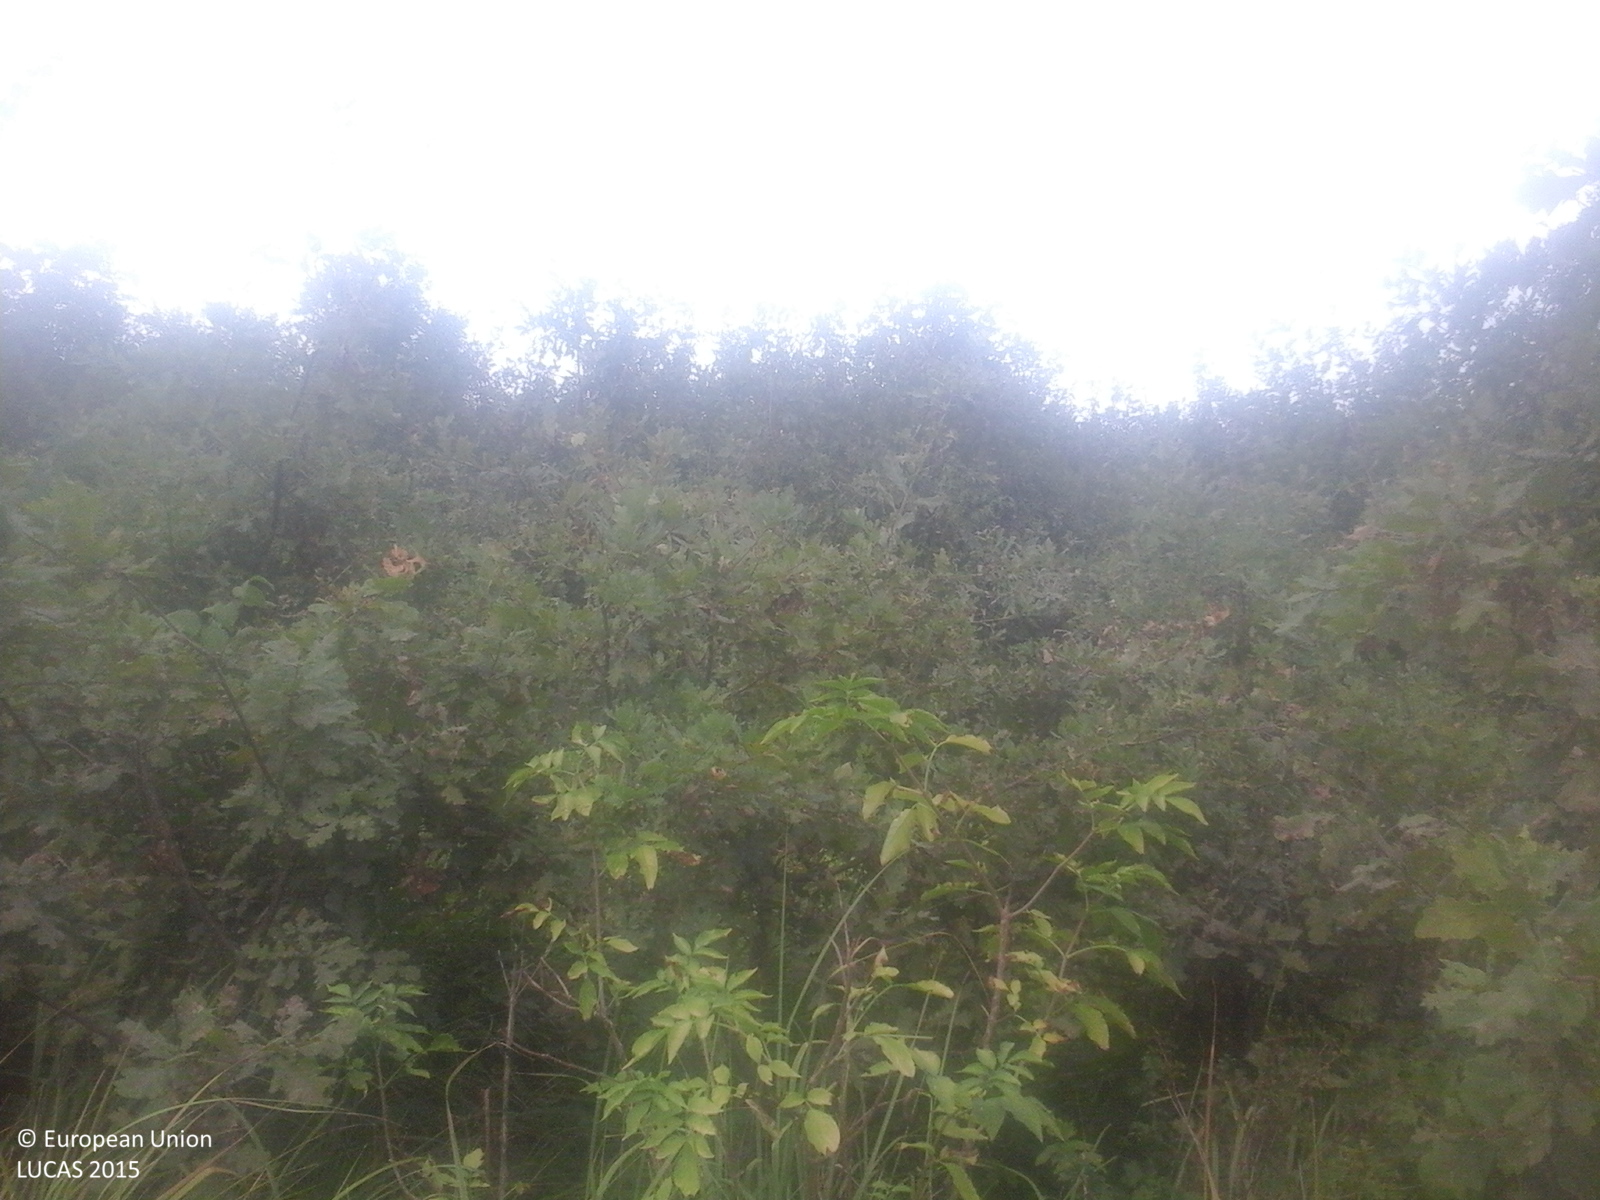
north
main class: Woodland
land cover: Broadleaved woodland
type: broadleaved evergreen forest
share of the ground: > 75 %
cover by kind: broadleaved forest trees 100 %
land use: Forestry
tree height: < 5 m
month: September
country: RO
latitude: 47.7177
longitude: 22.7390
